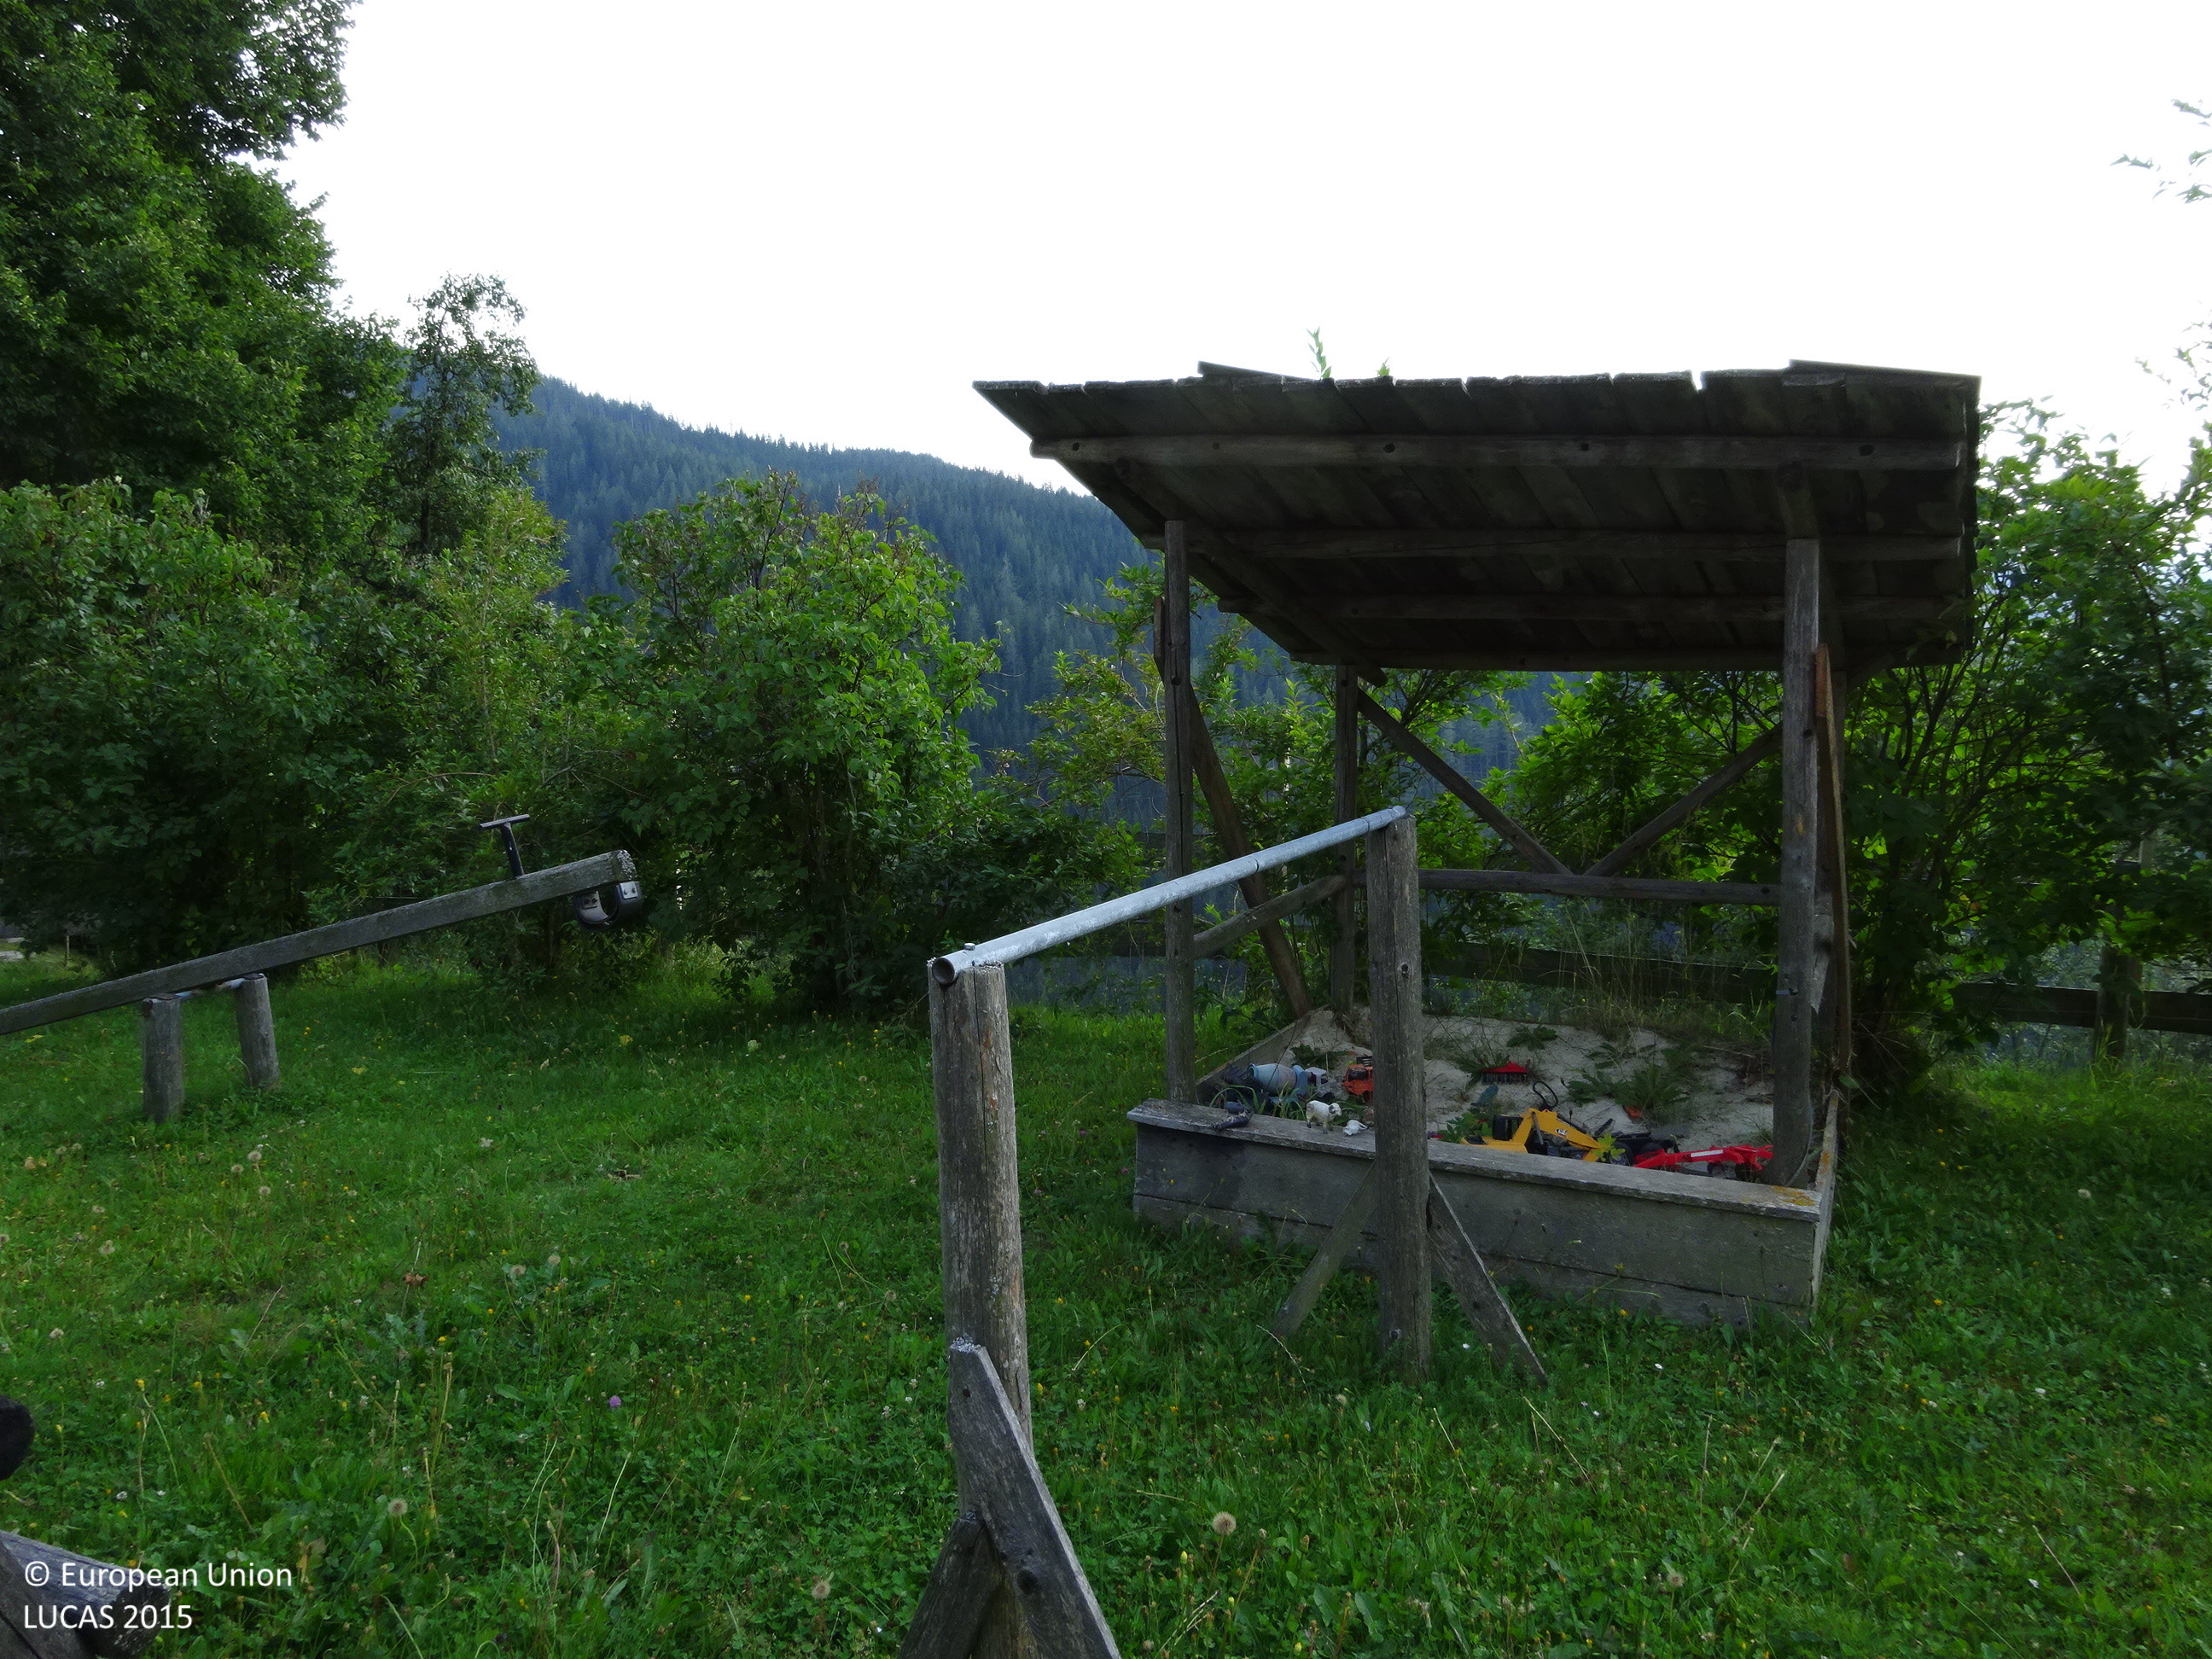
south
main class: Grassland
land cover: Grassland without tree/shrub cover
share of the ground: > 75 %
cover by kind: herbaceous plants 100 %
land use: Amenities, museums, leisure
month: August
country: AT
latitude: 47.5127
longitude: 15.7777
